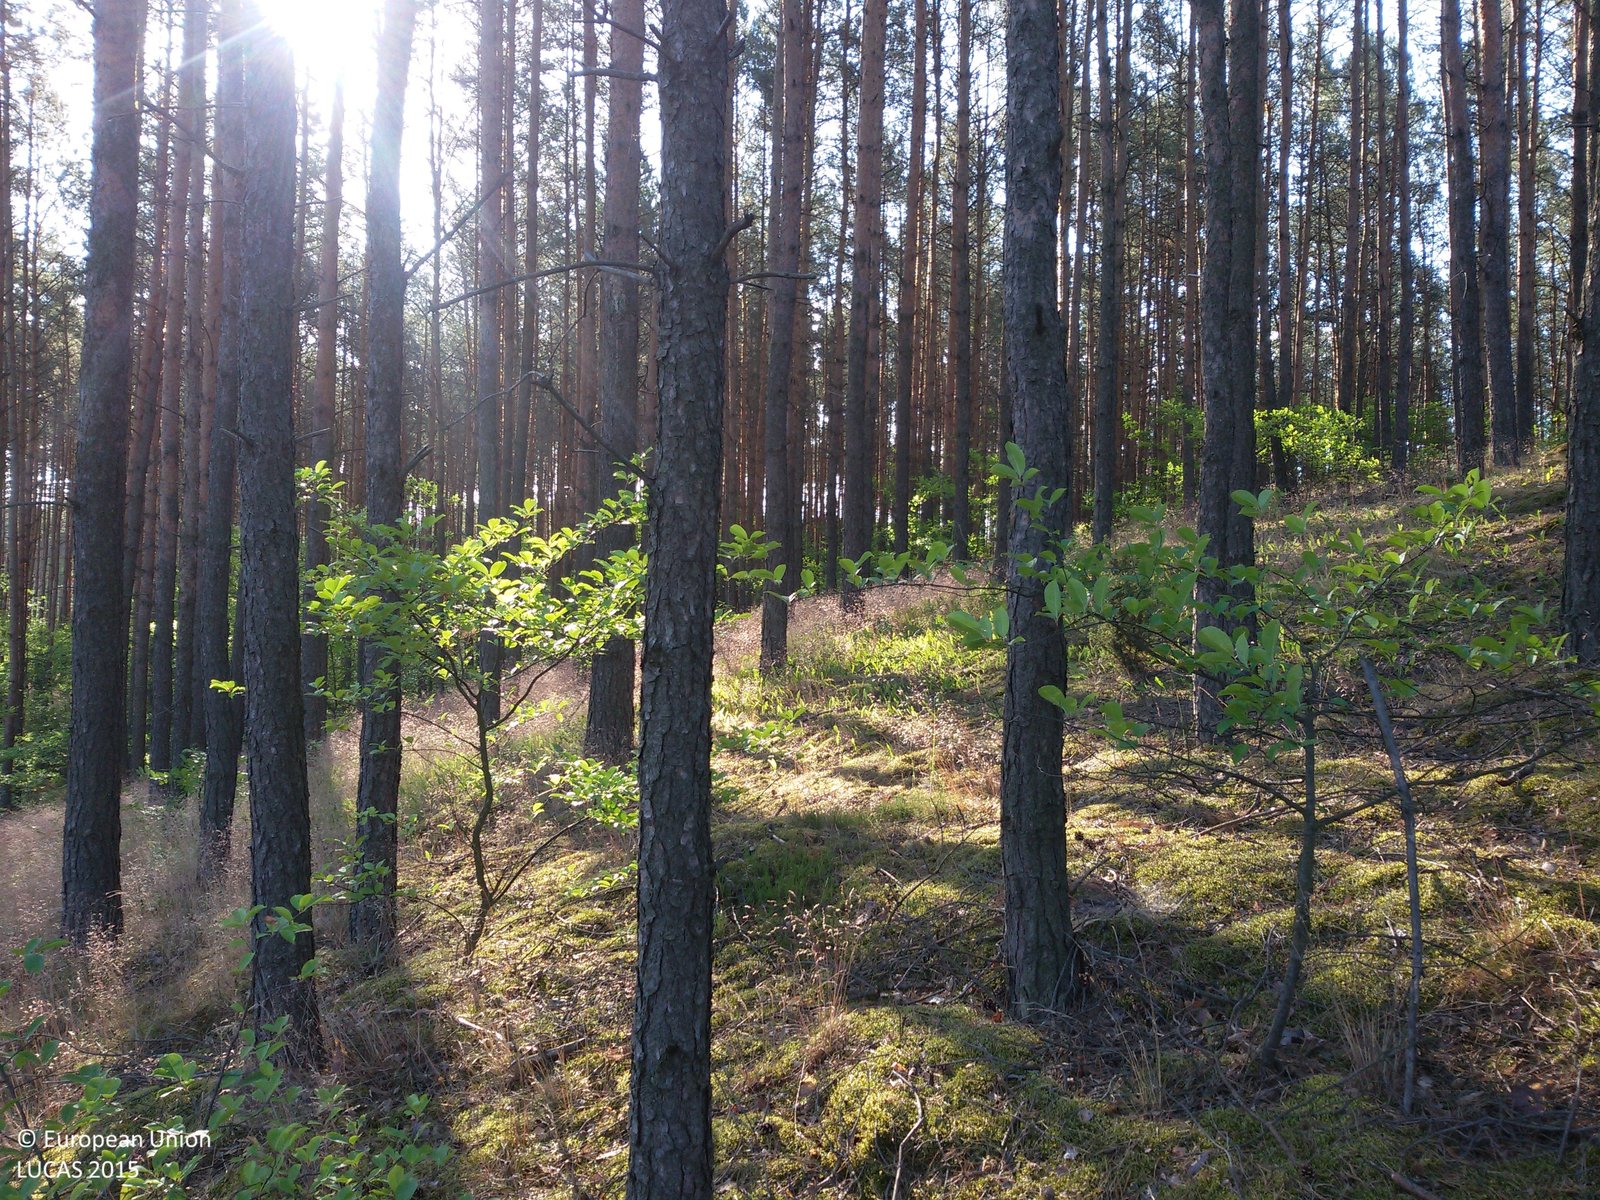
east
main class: Woodland
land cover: Pine dominated coniferous woodland
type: hemiboreal forest and nemoral coniferous forest and mixed broadleaved-coniferous forest
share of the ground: > 75 %
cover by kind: coniferous forest trees 80 %, herbaceous plants 10 %, shrubs 5 %, lichens and mosses 5 %
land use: Forestry
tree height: > 5 m
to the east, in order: Pine dominated coniferous woodland; Tracks; Pine dominated coniferous woodland
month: July
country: PL
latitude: 52.6105
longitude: 19.0465
